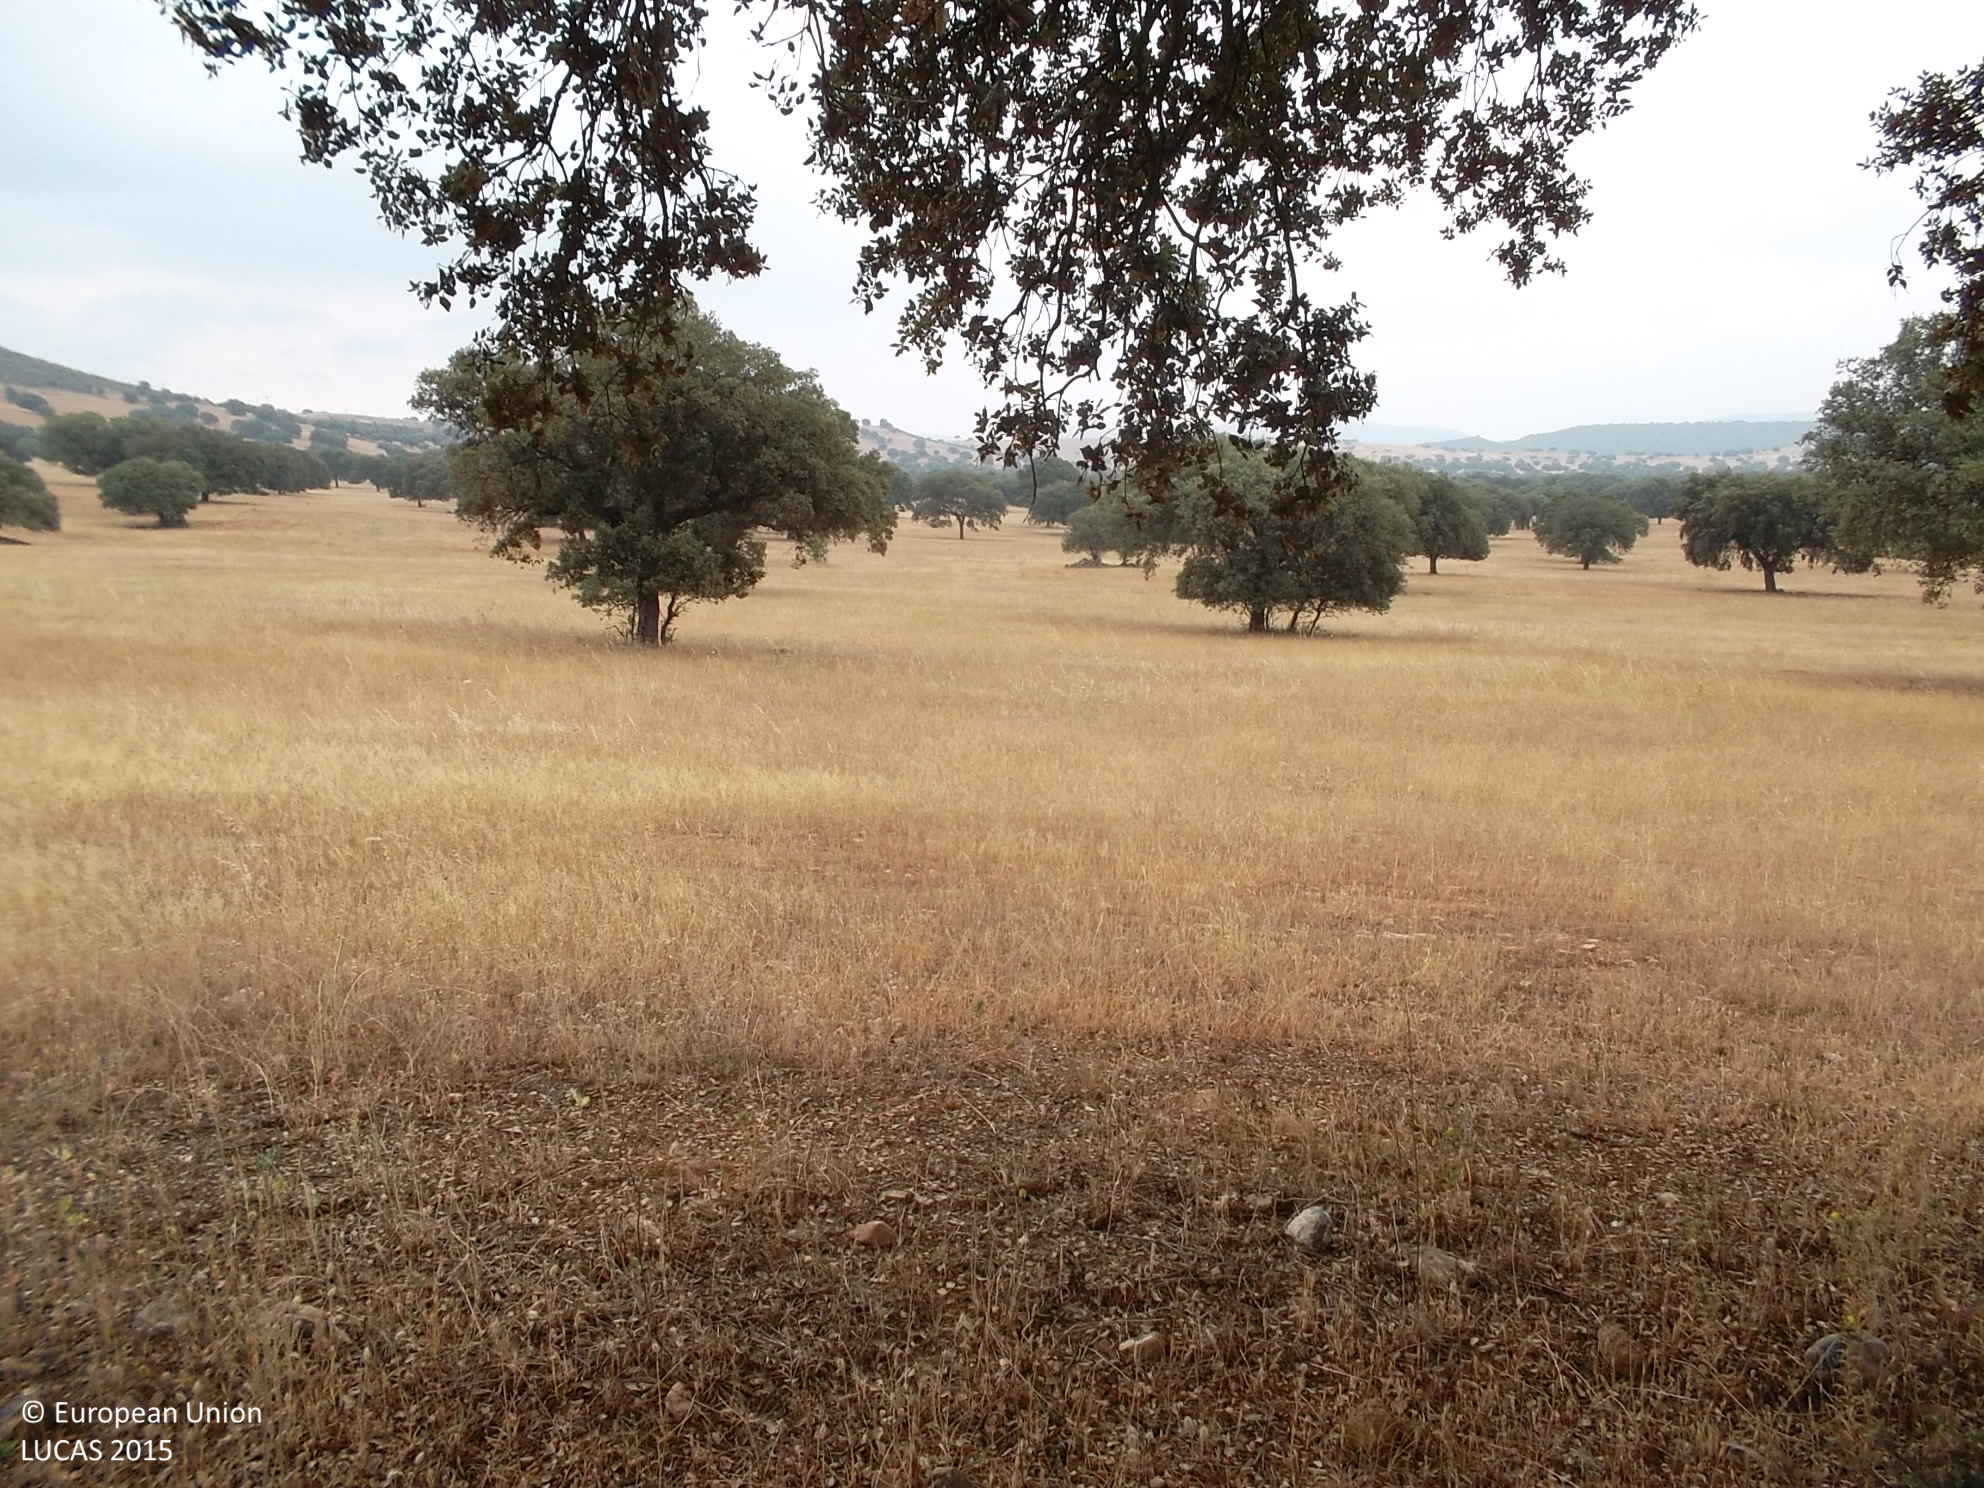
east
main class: Woodland
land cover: Broadleaved woodland
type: broadleaved evergreen forest
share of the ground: 25 - 50 %
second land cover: Grassland without tree/shrub cover
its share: > 75 %
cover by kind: broadleaved forest trees 30 %, herbaceous plants 30 %, shrubs 20 %, unconsolidated bare surface 20 %
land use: Forestry
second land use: Agriculture (excluding fallow land and kitchen gardens)
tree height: > 5 m
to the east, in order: Broadleaved woodland; Grassland without tree/shrub cover
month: June
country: ES
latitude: 39.0219
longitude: -4.4777
